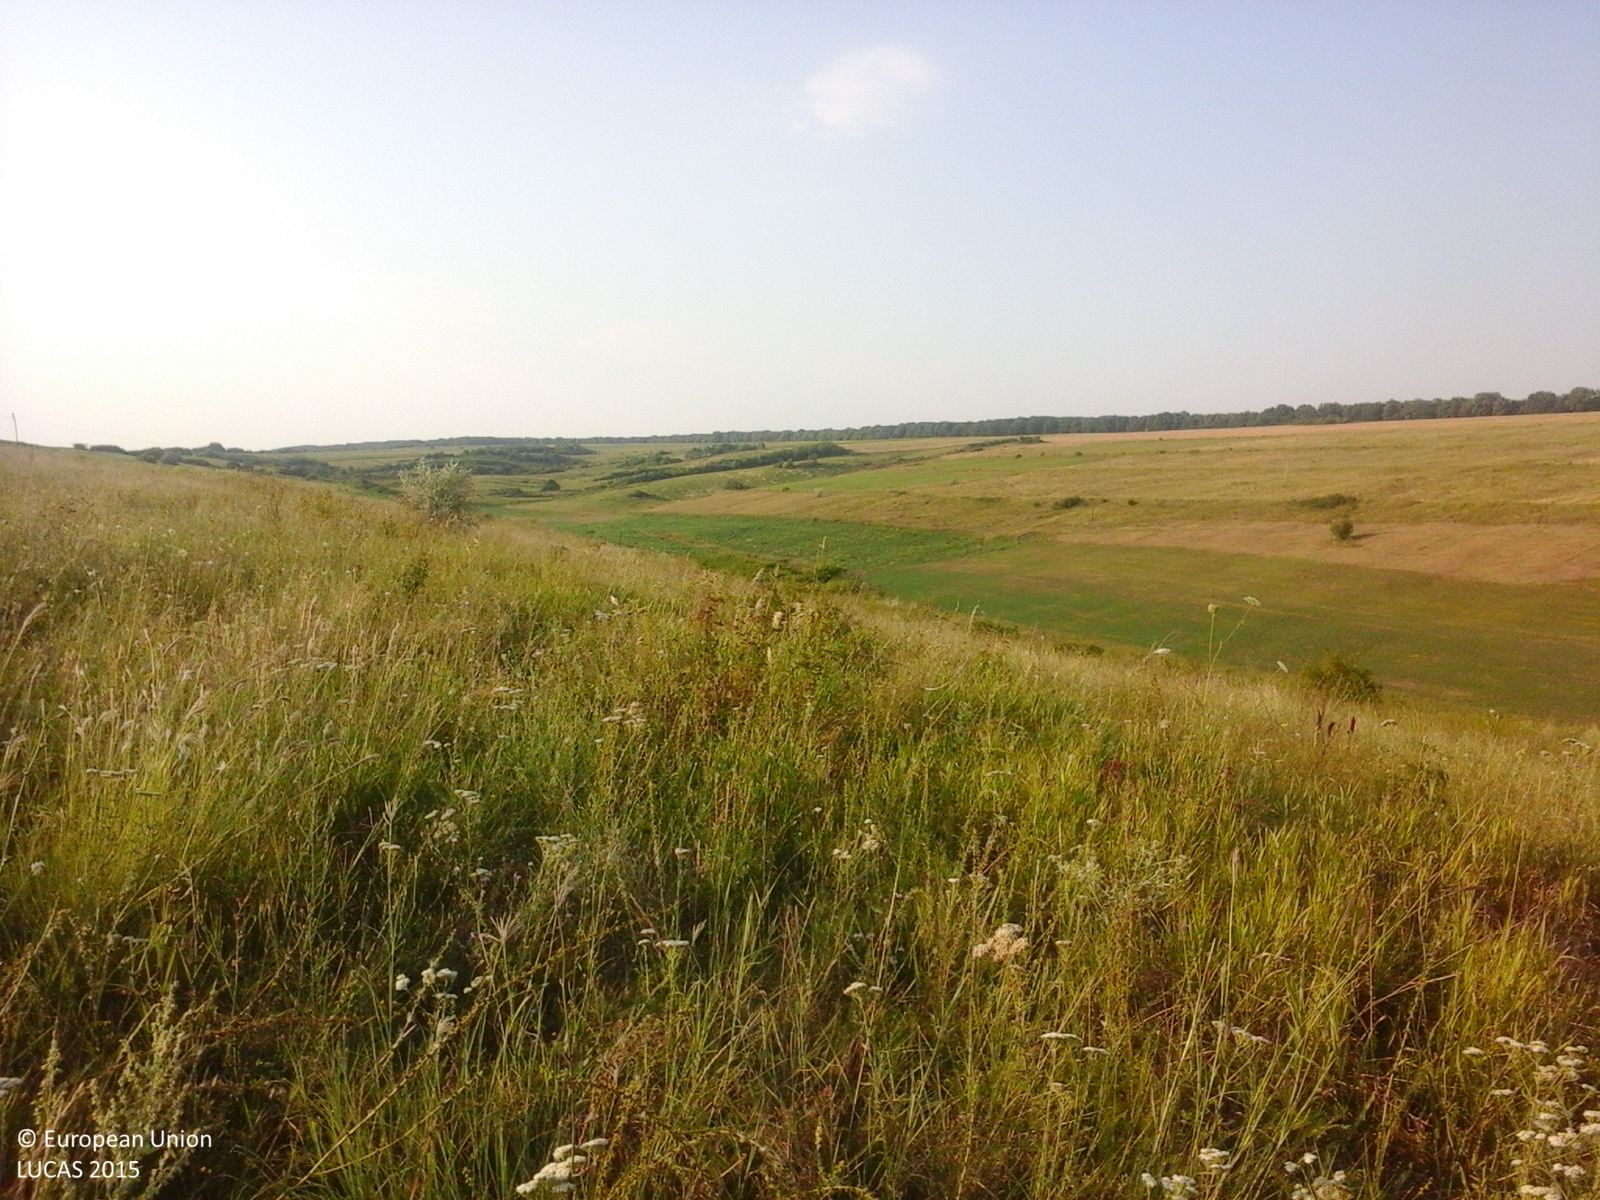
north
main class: Grassland
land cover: Grassland without tree/shrub cover
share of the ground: > 75 %
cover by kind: herbaceous plants 100 %
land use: Agriculture (excluding fallow land and kitchen gardens)
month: July
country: RO
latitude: 46.4217
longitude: 27.6142
